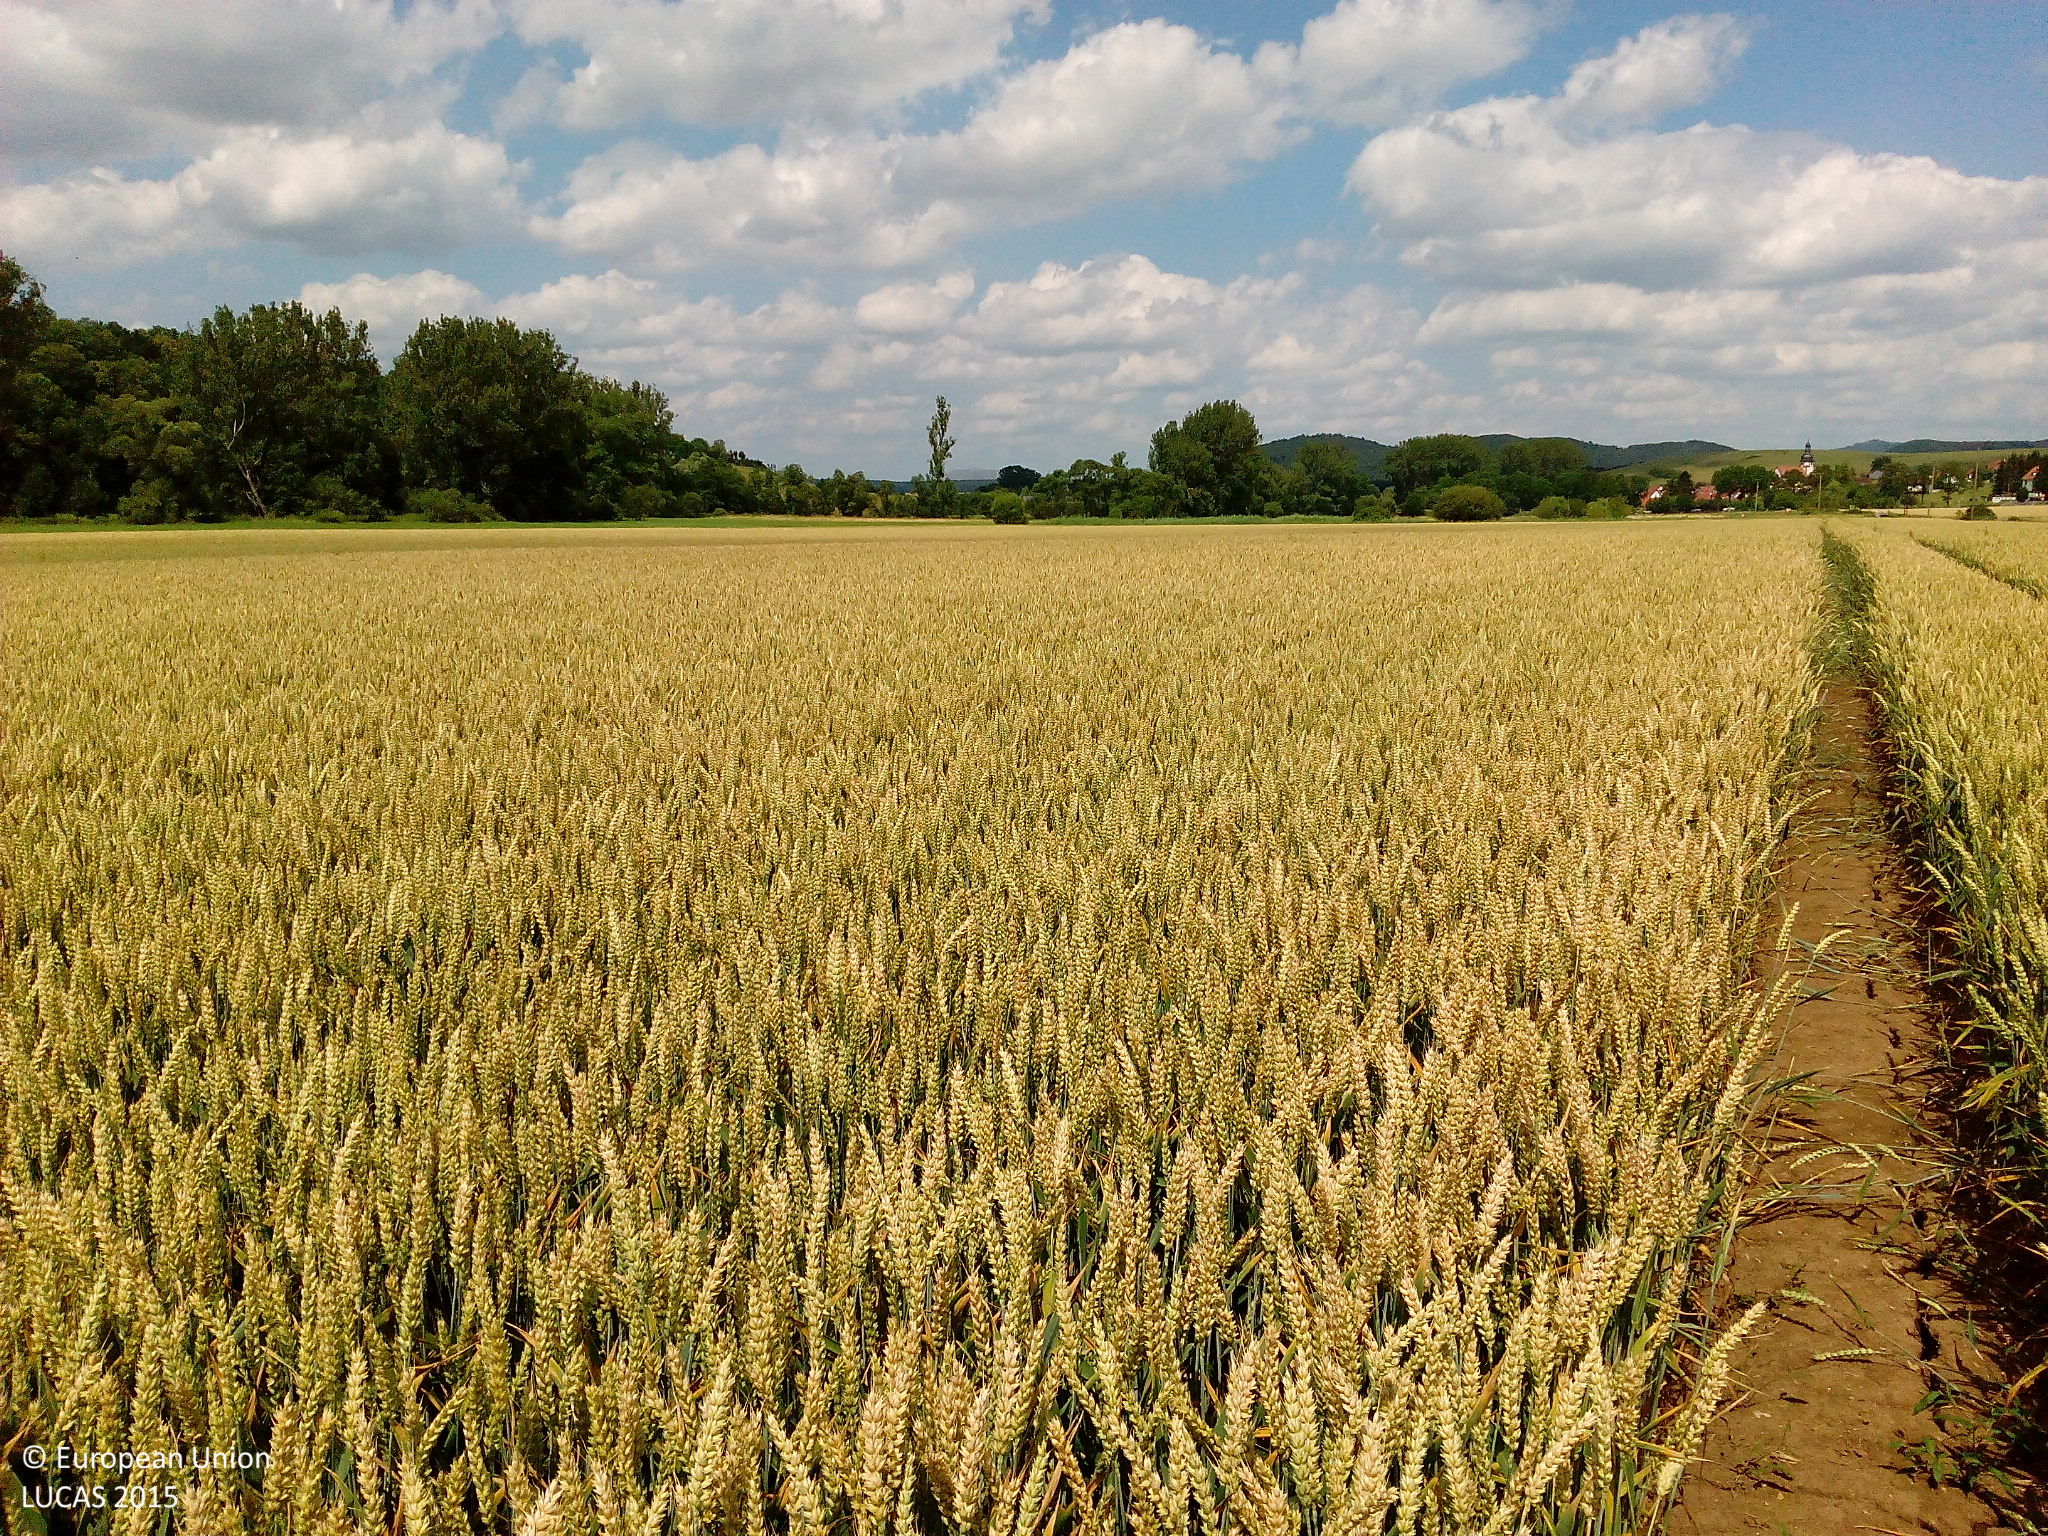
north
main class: Cropland
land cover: Common wheat
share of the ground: > 75 %
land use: Agriculture (excluding fallow land and kitchen gardens)
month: July
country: DE
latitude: 50.7236
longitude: 9.9575
